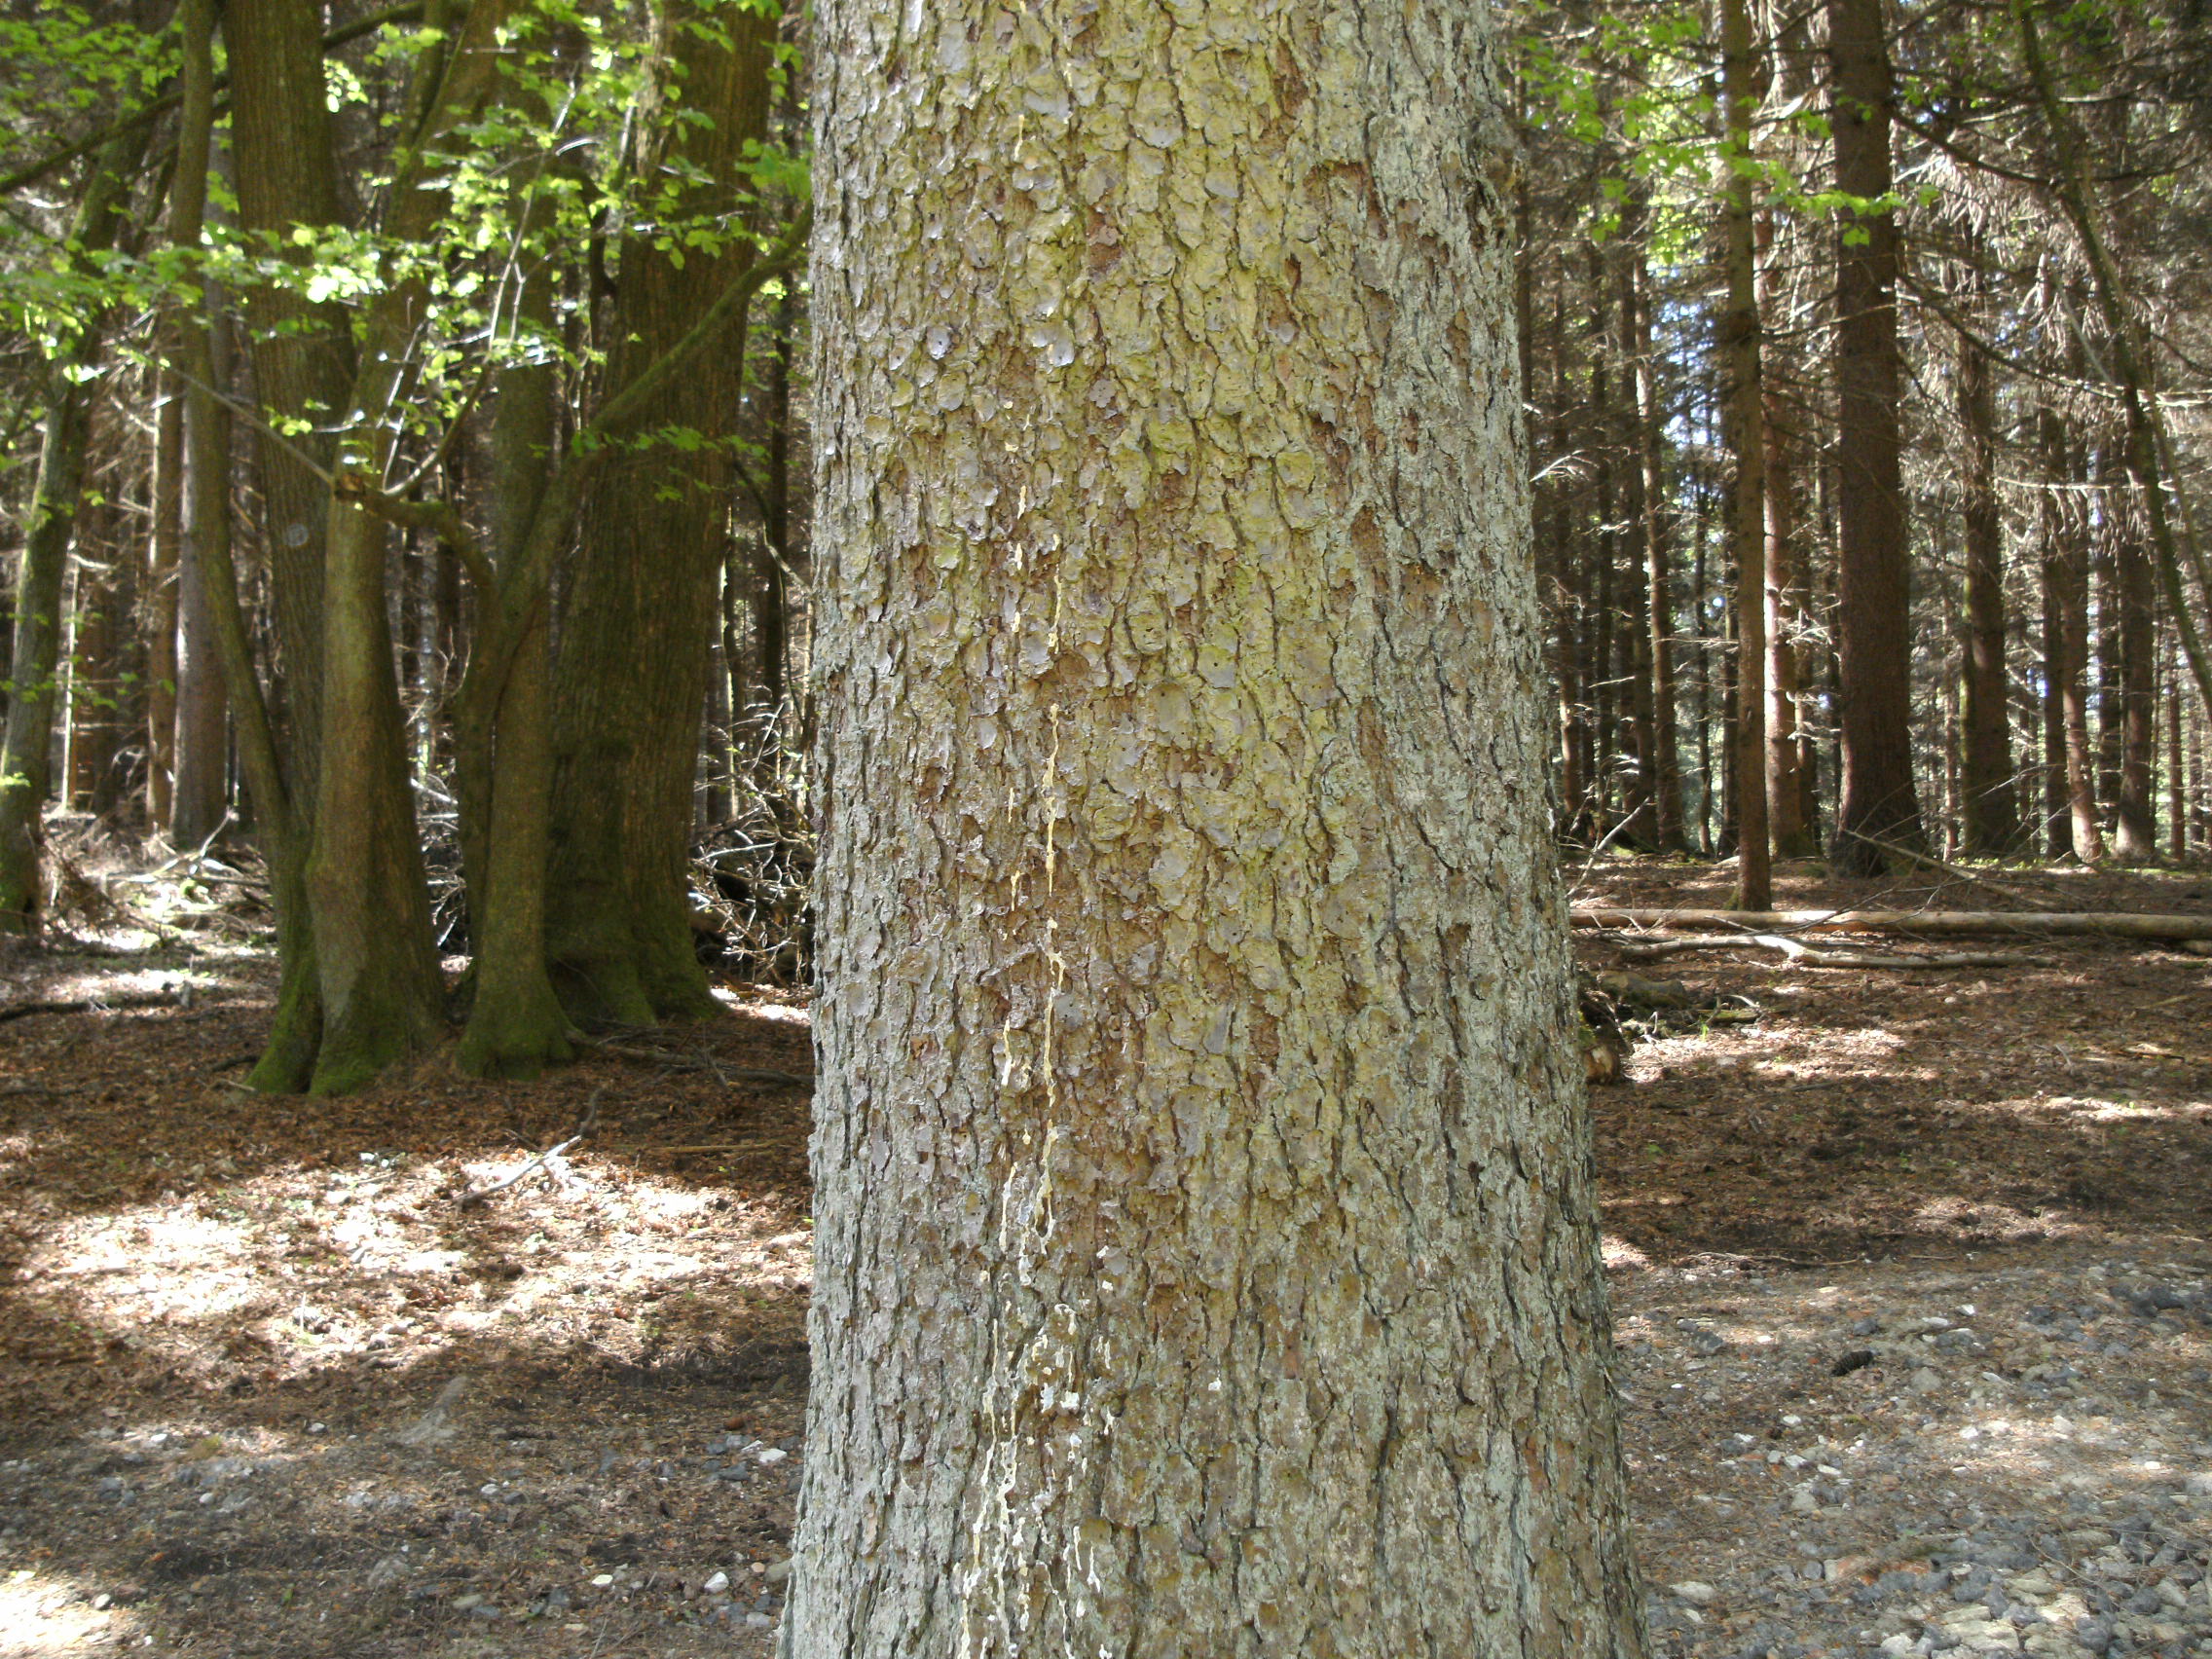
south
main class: Woodland
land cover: Spruce dominated mixed woodland
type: hemiboreal forest and nemoral coniferous forest and mixed broadleaved-coniferous forest
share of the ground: > 75 %
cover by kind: coniferous forest trees 45 %, broadleaved forest trees 45 %, shrubs 10 %
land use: Forestry
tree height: > 5 m
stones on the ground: 25 - 50 %
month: May
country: AT
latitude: 48.5092
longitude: 13.5325
